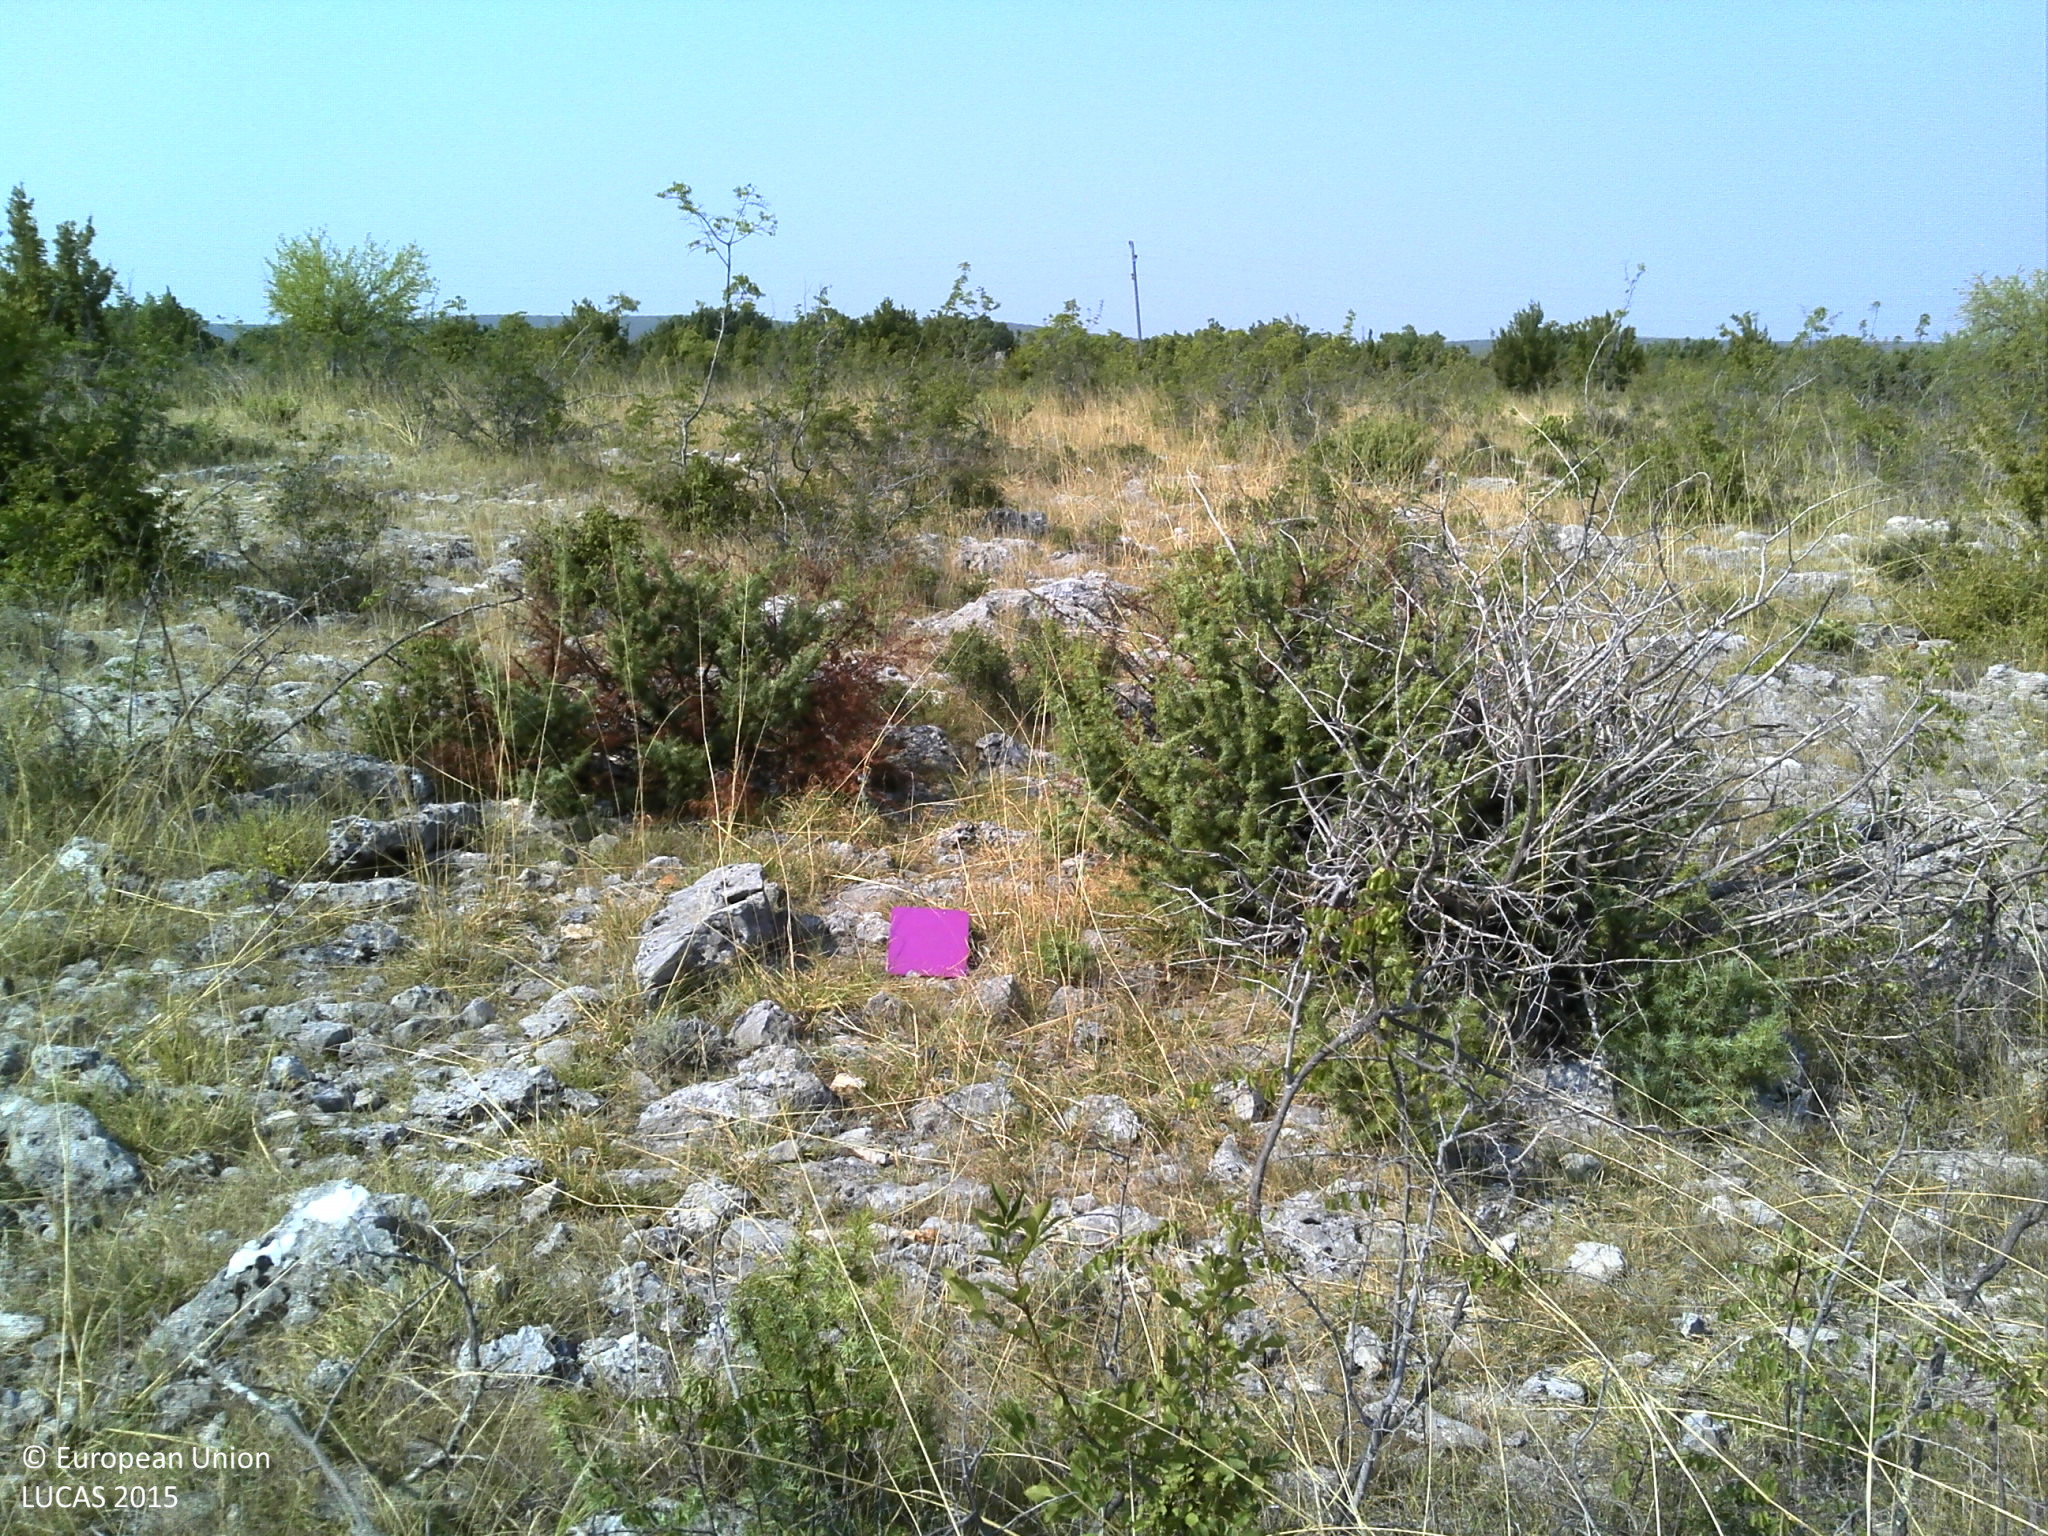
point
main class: Shrubland
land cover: Shrubland without tree cover
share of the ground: 25 - 50 %
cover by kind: herbaceous plants 40 %, shrubs 30 %, unconsolidated bare surface 20 %, consolidated bare surface 10 %
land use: Semi-natural and natural areas not in use
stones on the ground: 25 - 50 %
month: August
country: HR
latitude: 44.0203
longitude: 15.8928
